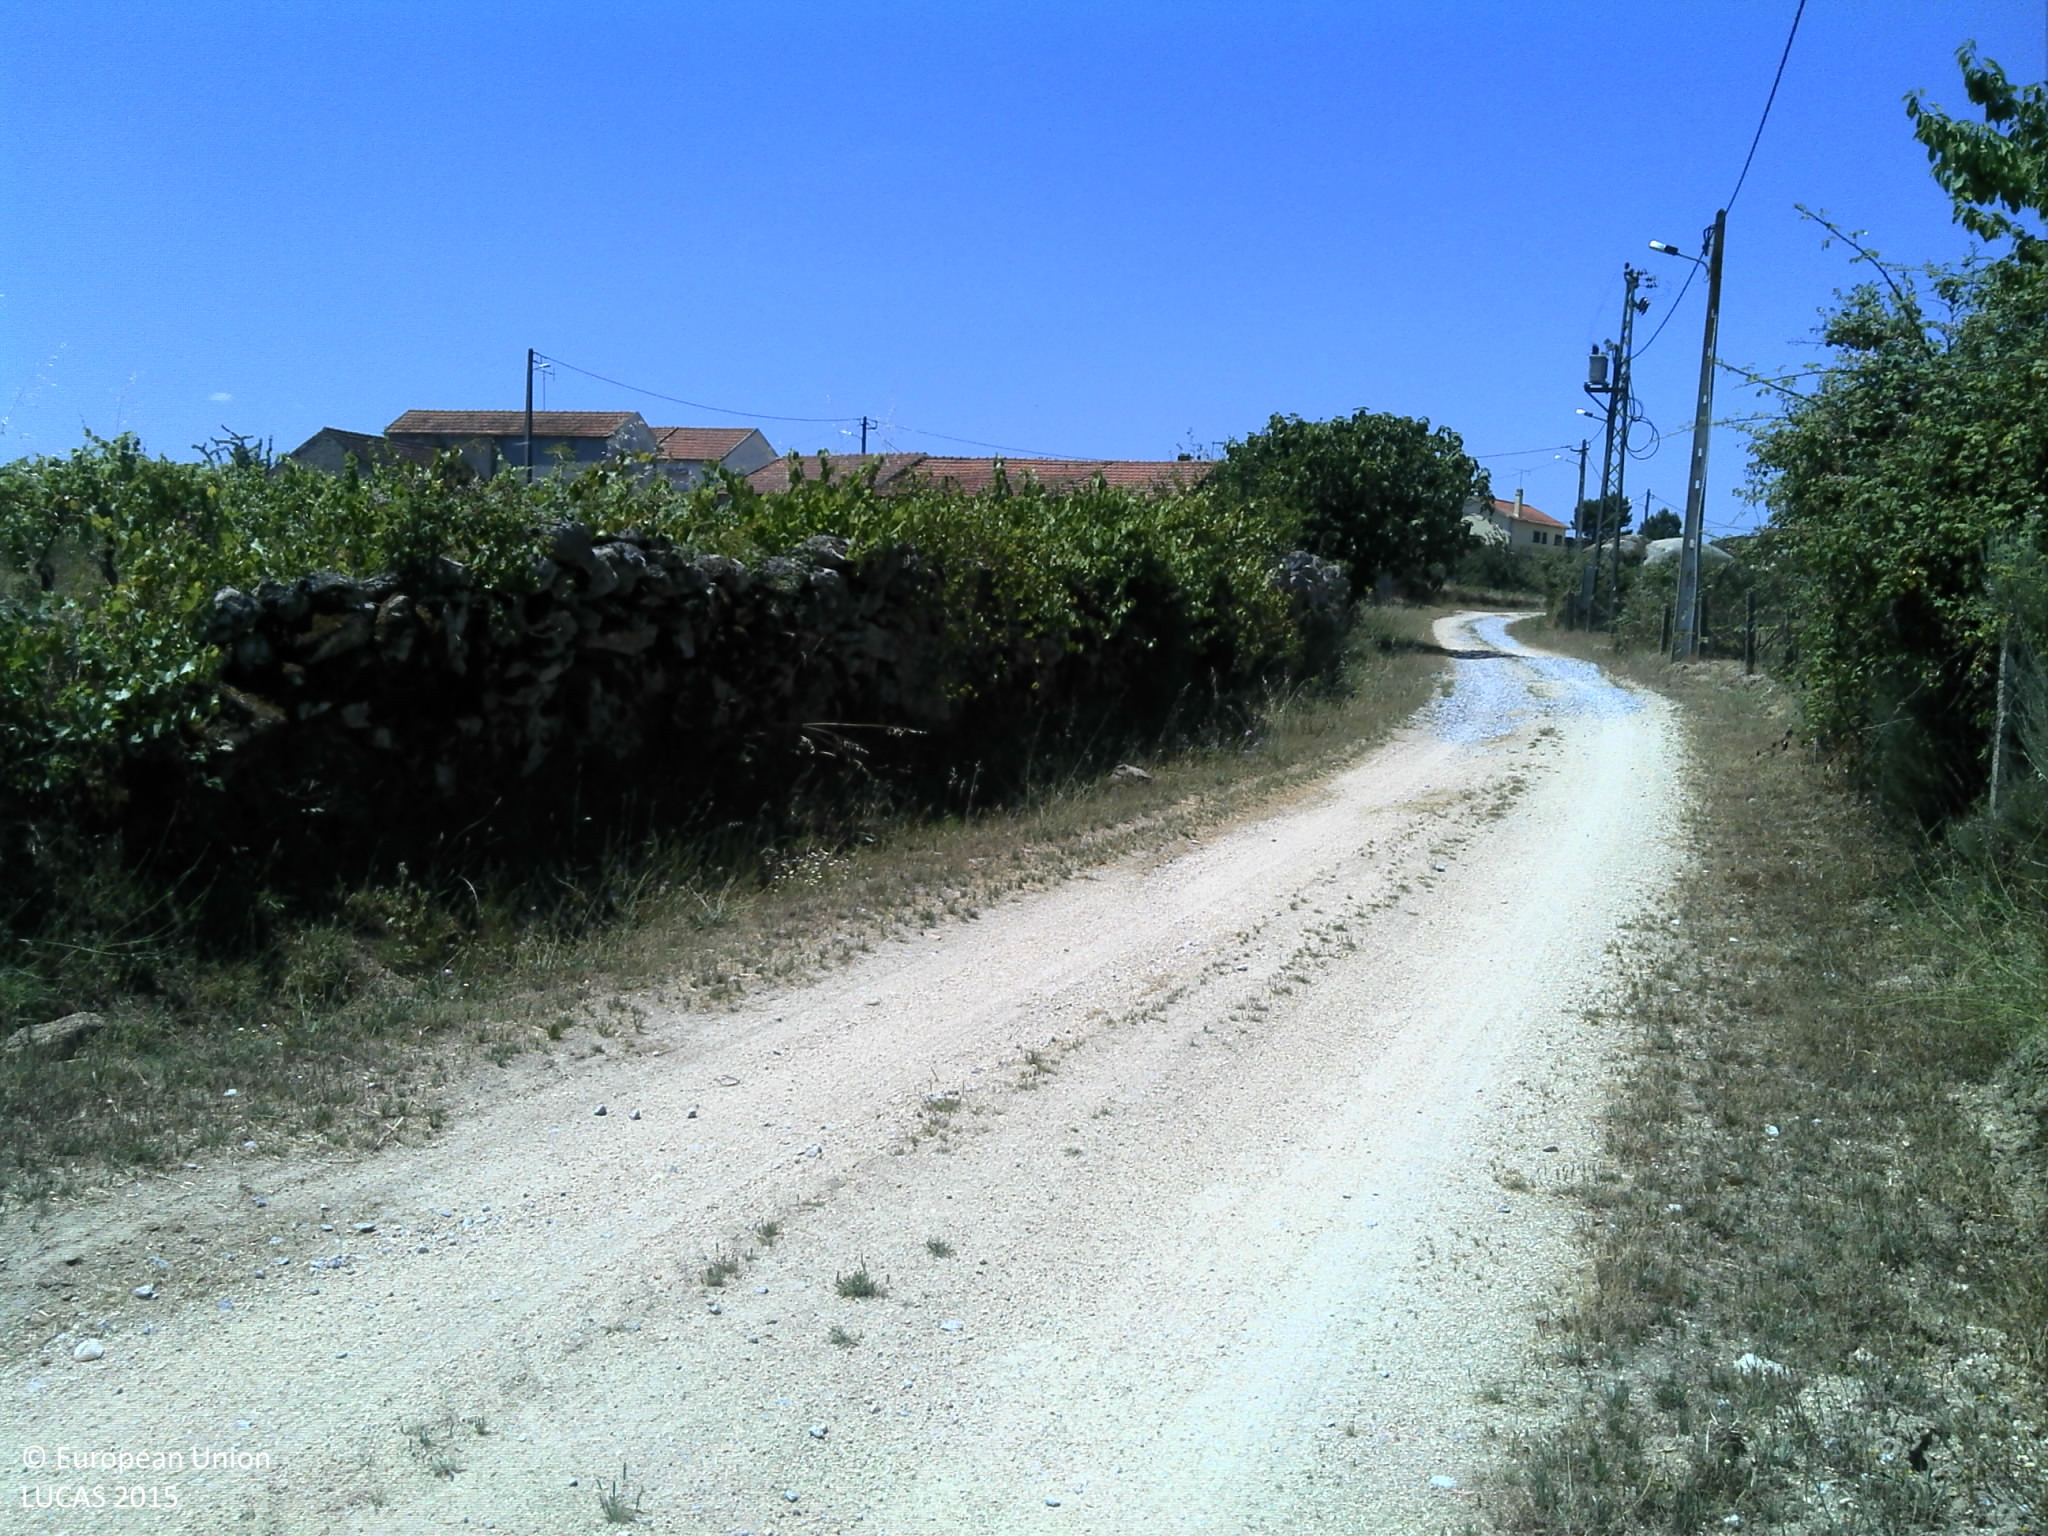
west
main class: Grassland
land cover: Grassland without tree/shrub cover
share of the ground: > 75 %
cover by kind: herbaceous plants 80 %, unconsolidated bare surface 20 %
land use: Agriculture (excluding fallow land and kitchen gardens)
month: June
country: PT
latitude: 40.7327
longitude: -7.1692
